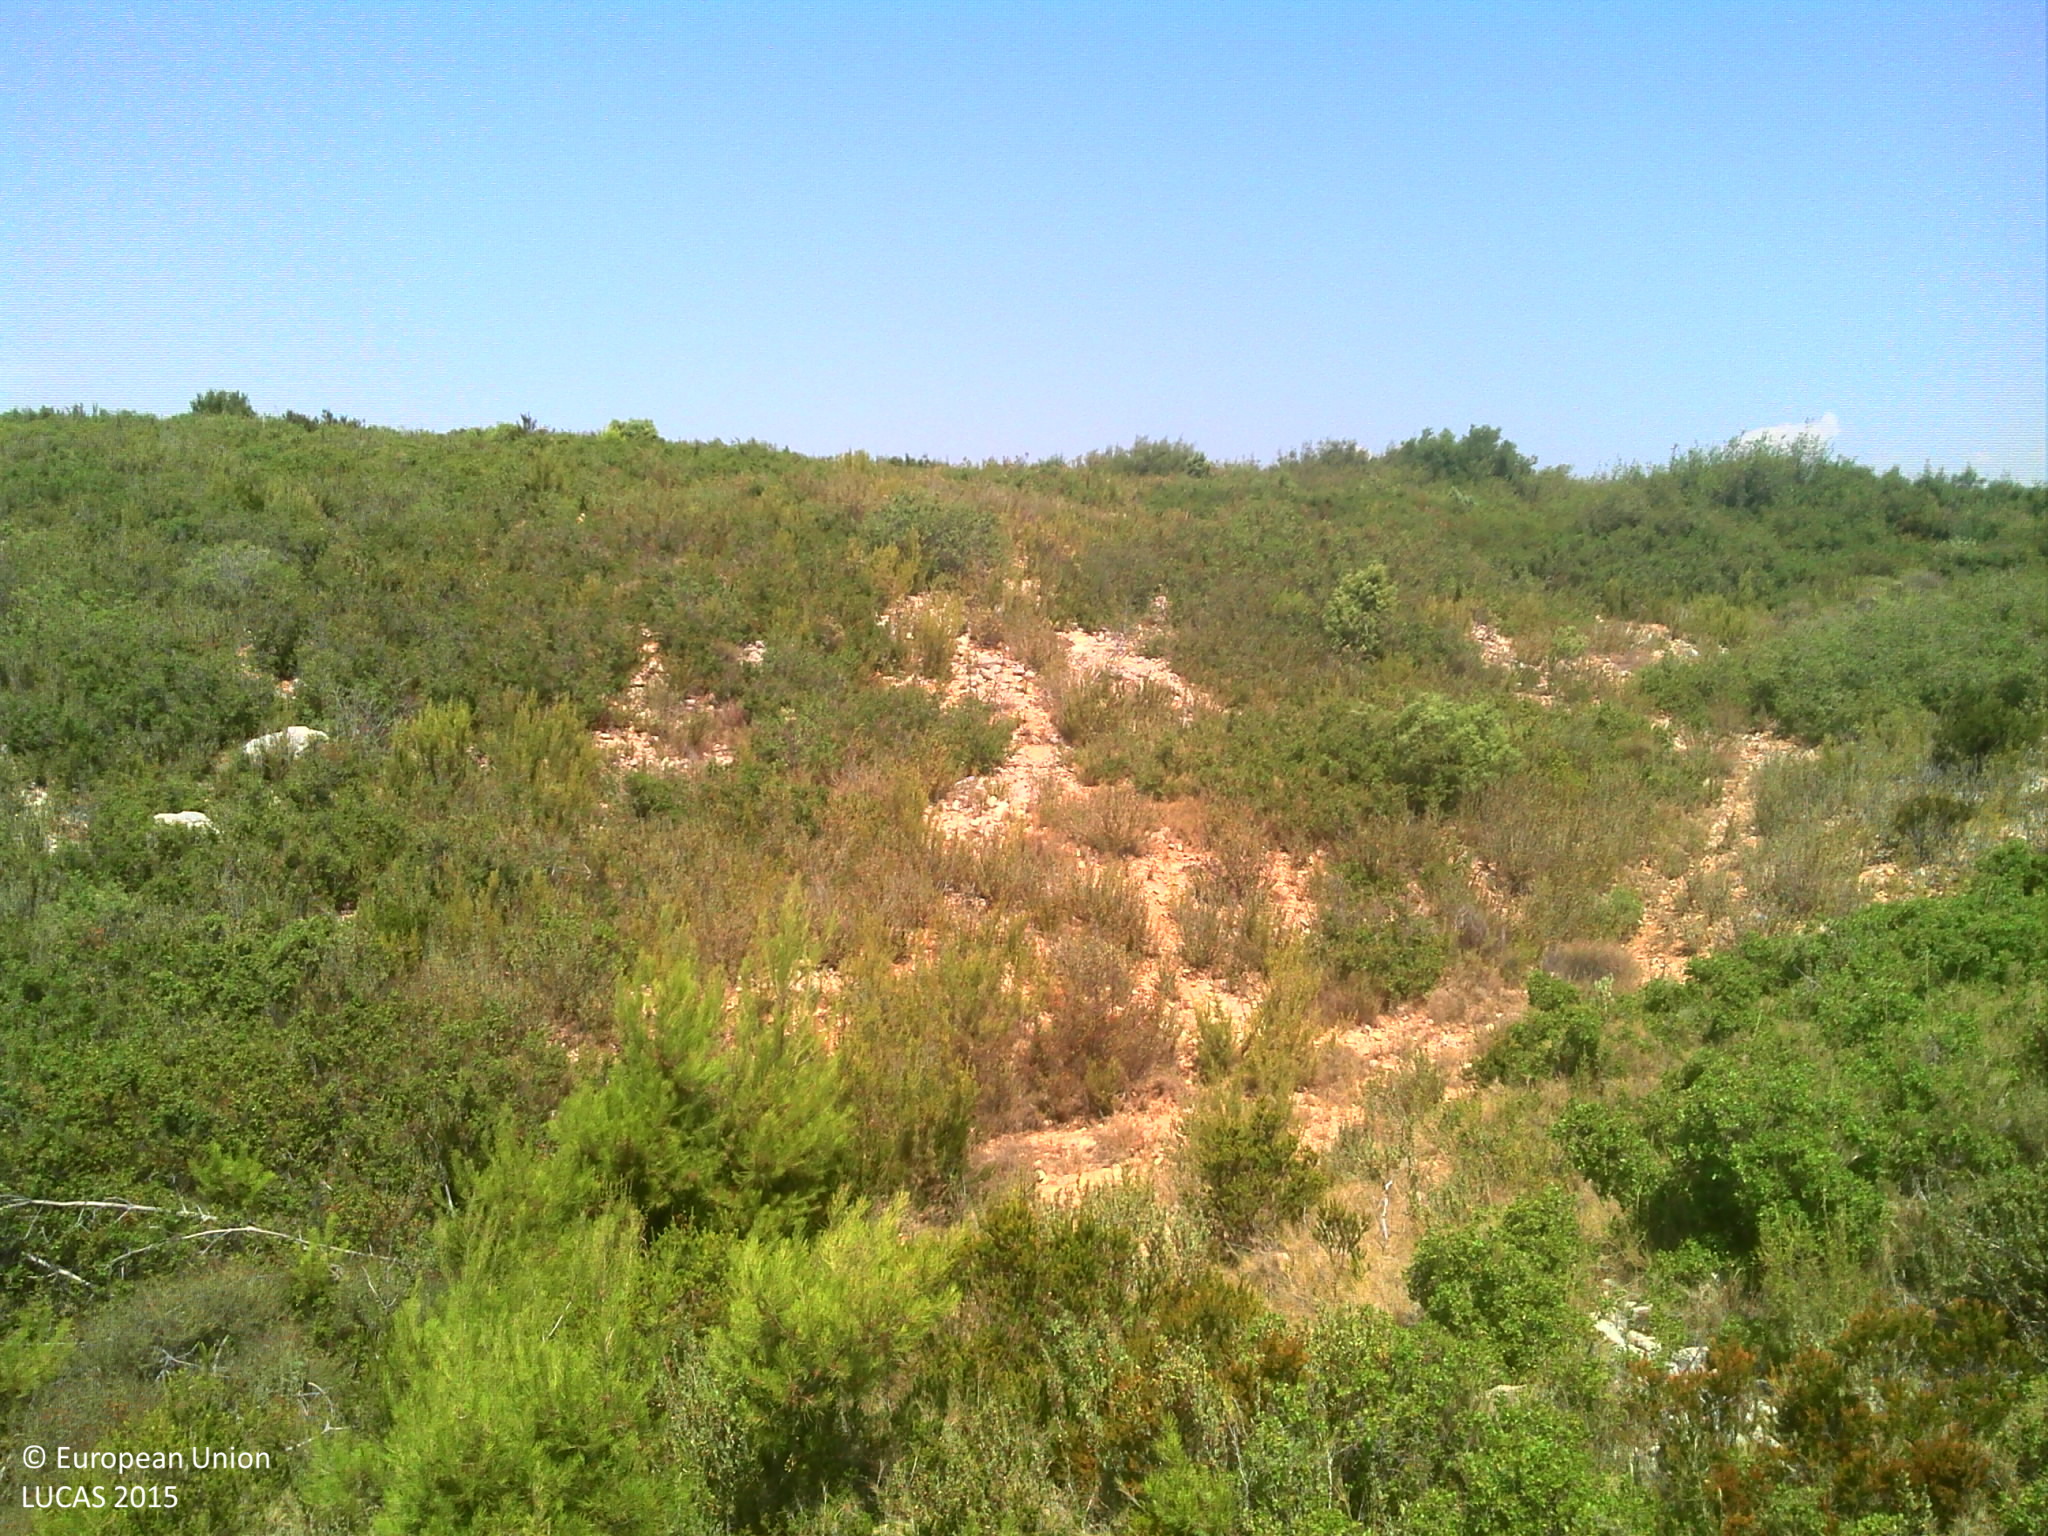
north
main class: Shrubland
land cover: Shrubland without tree cover
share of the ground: > 75 %
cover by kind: shrubs 80 %, unconsolidated bare surface 15 %, consolidated bare surface 5 %
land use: Semi-natural and natural areas not in use
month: August
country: FR
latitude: 43.4660
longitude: 5.2759
